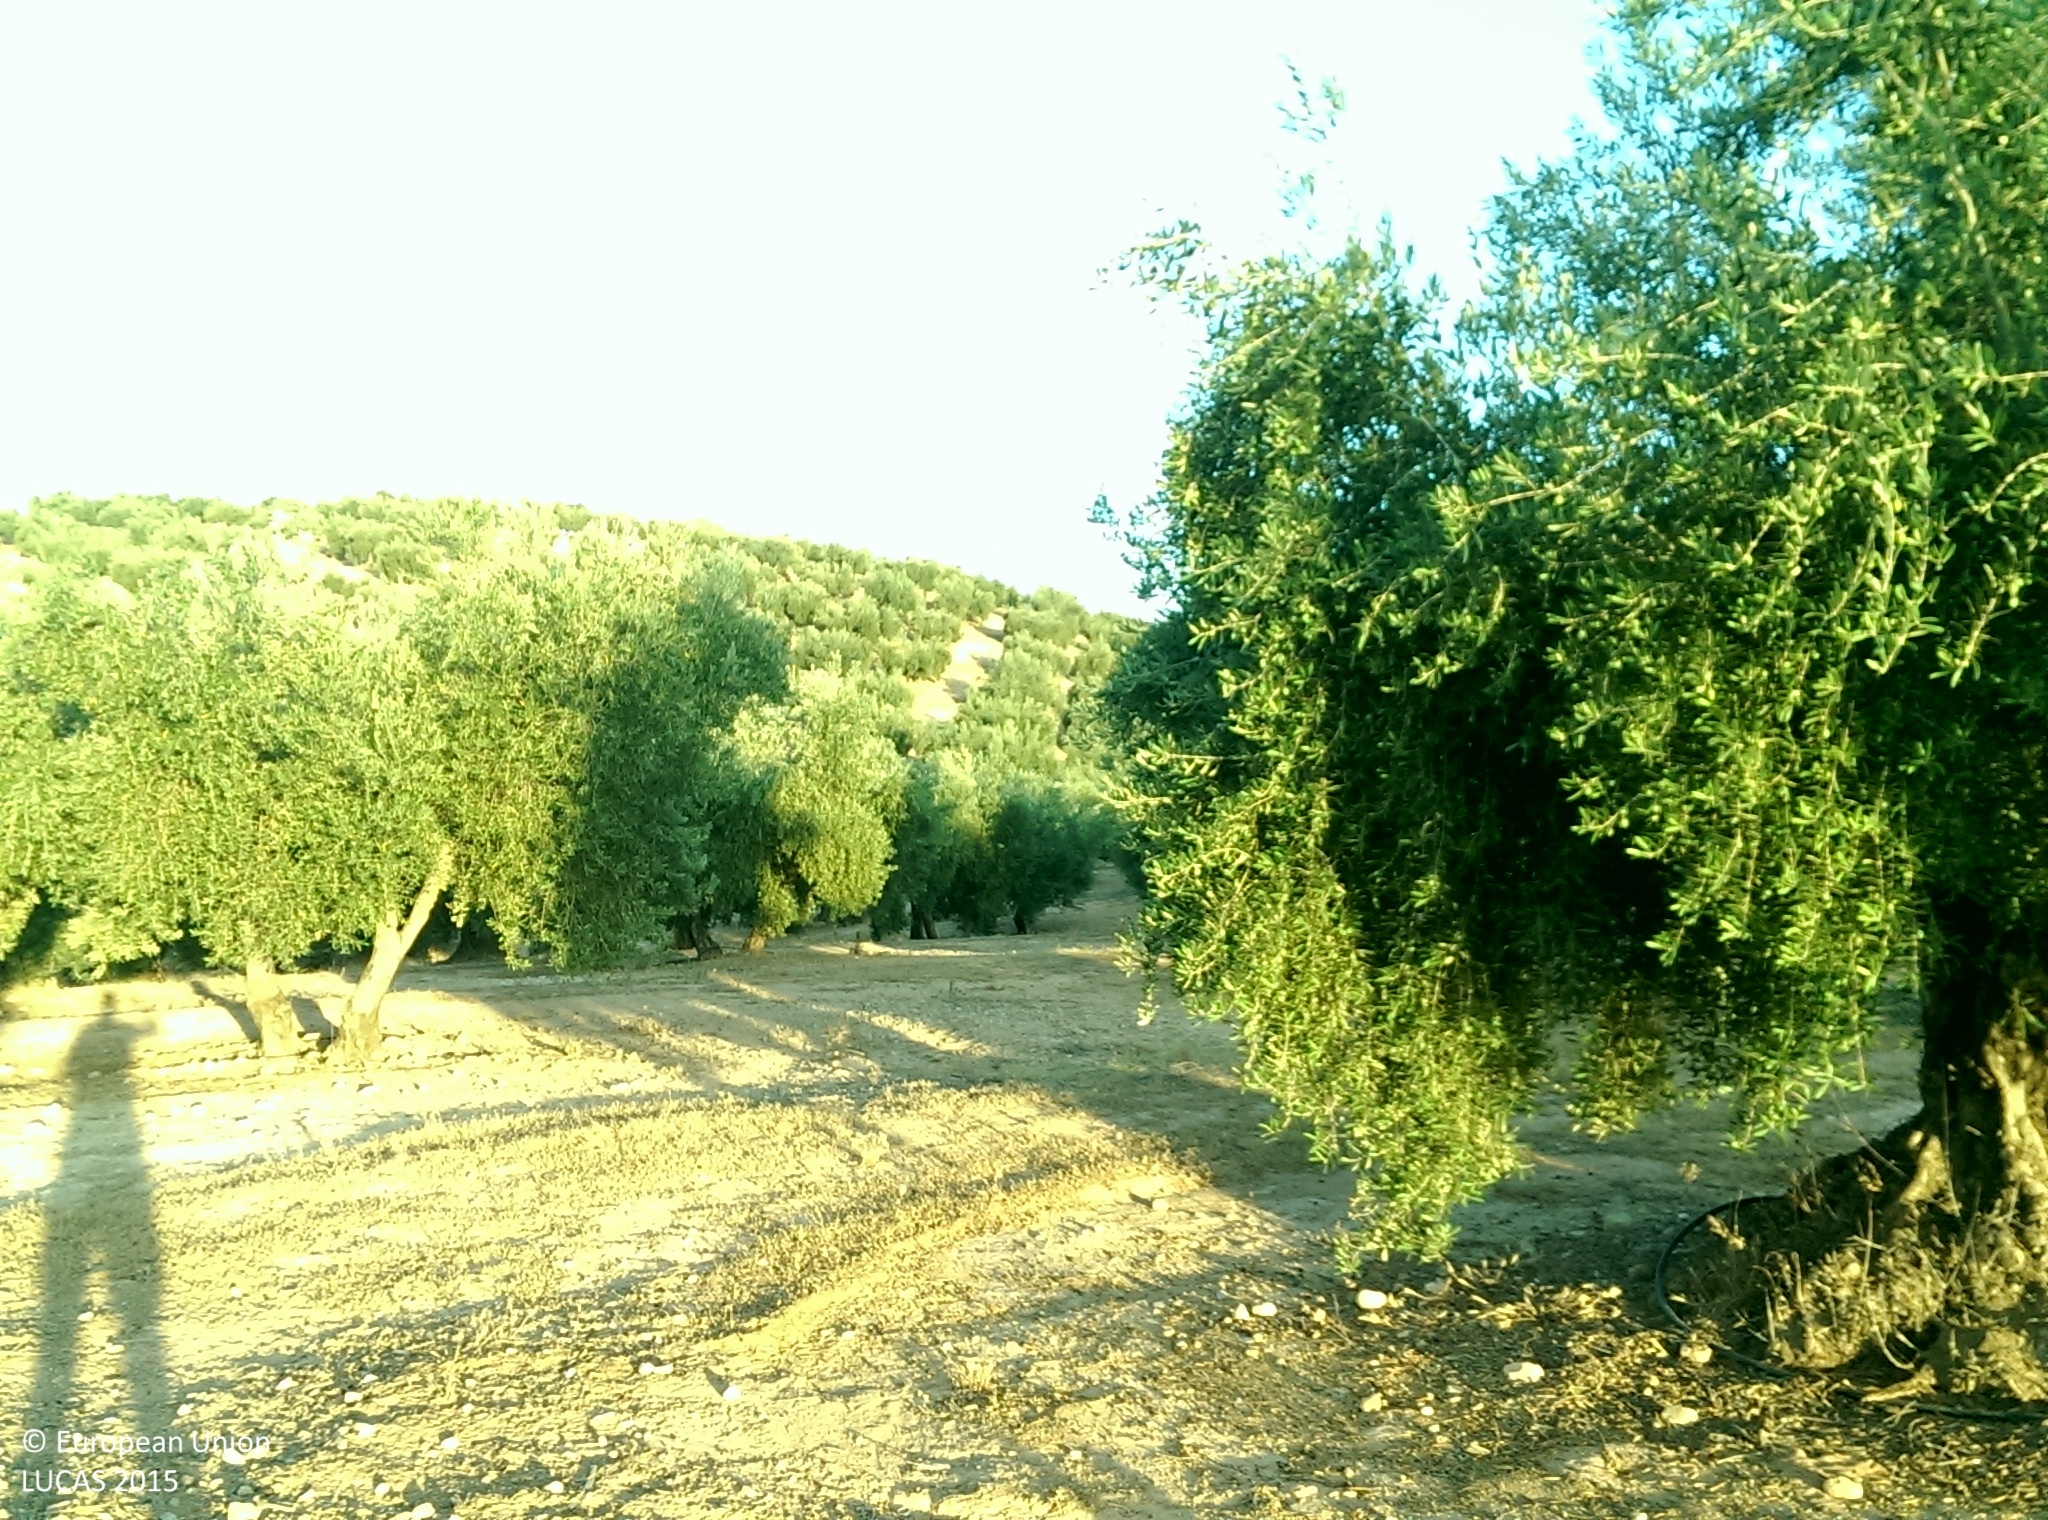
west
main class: Cropland
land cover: Olive groves
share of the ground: 50 - 75 %
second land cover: Other bare soil
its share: > 75 %
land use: Agriculture (excluding fallow land and kitchen gardens)
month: July
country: ES
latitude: 37.3408
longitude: -3.6846
